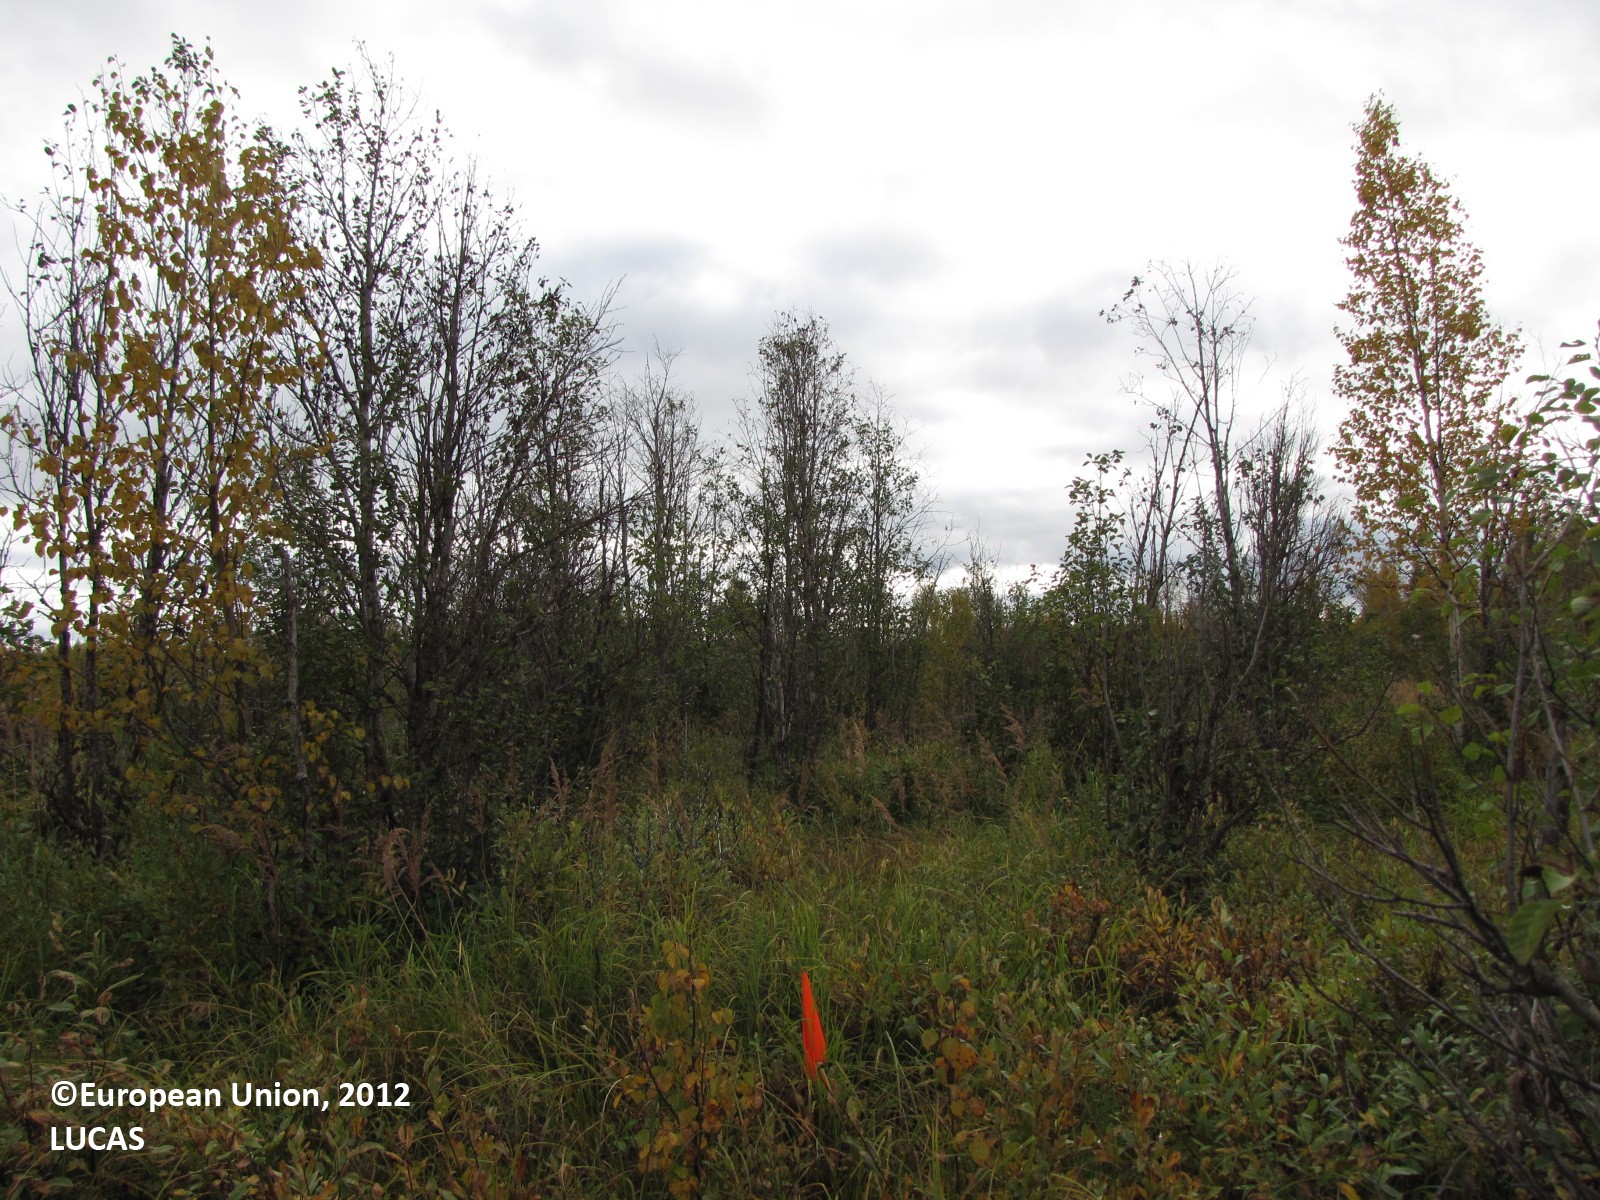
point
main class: Woodland
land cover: Broadleaved woodland
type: boreal forest
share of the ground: 10 - 25 %
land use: Forestry
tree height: > 5 m
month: September
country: FI
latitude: 67.1983
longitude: 23.5945
